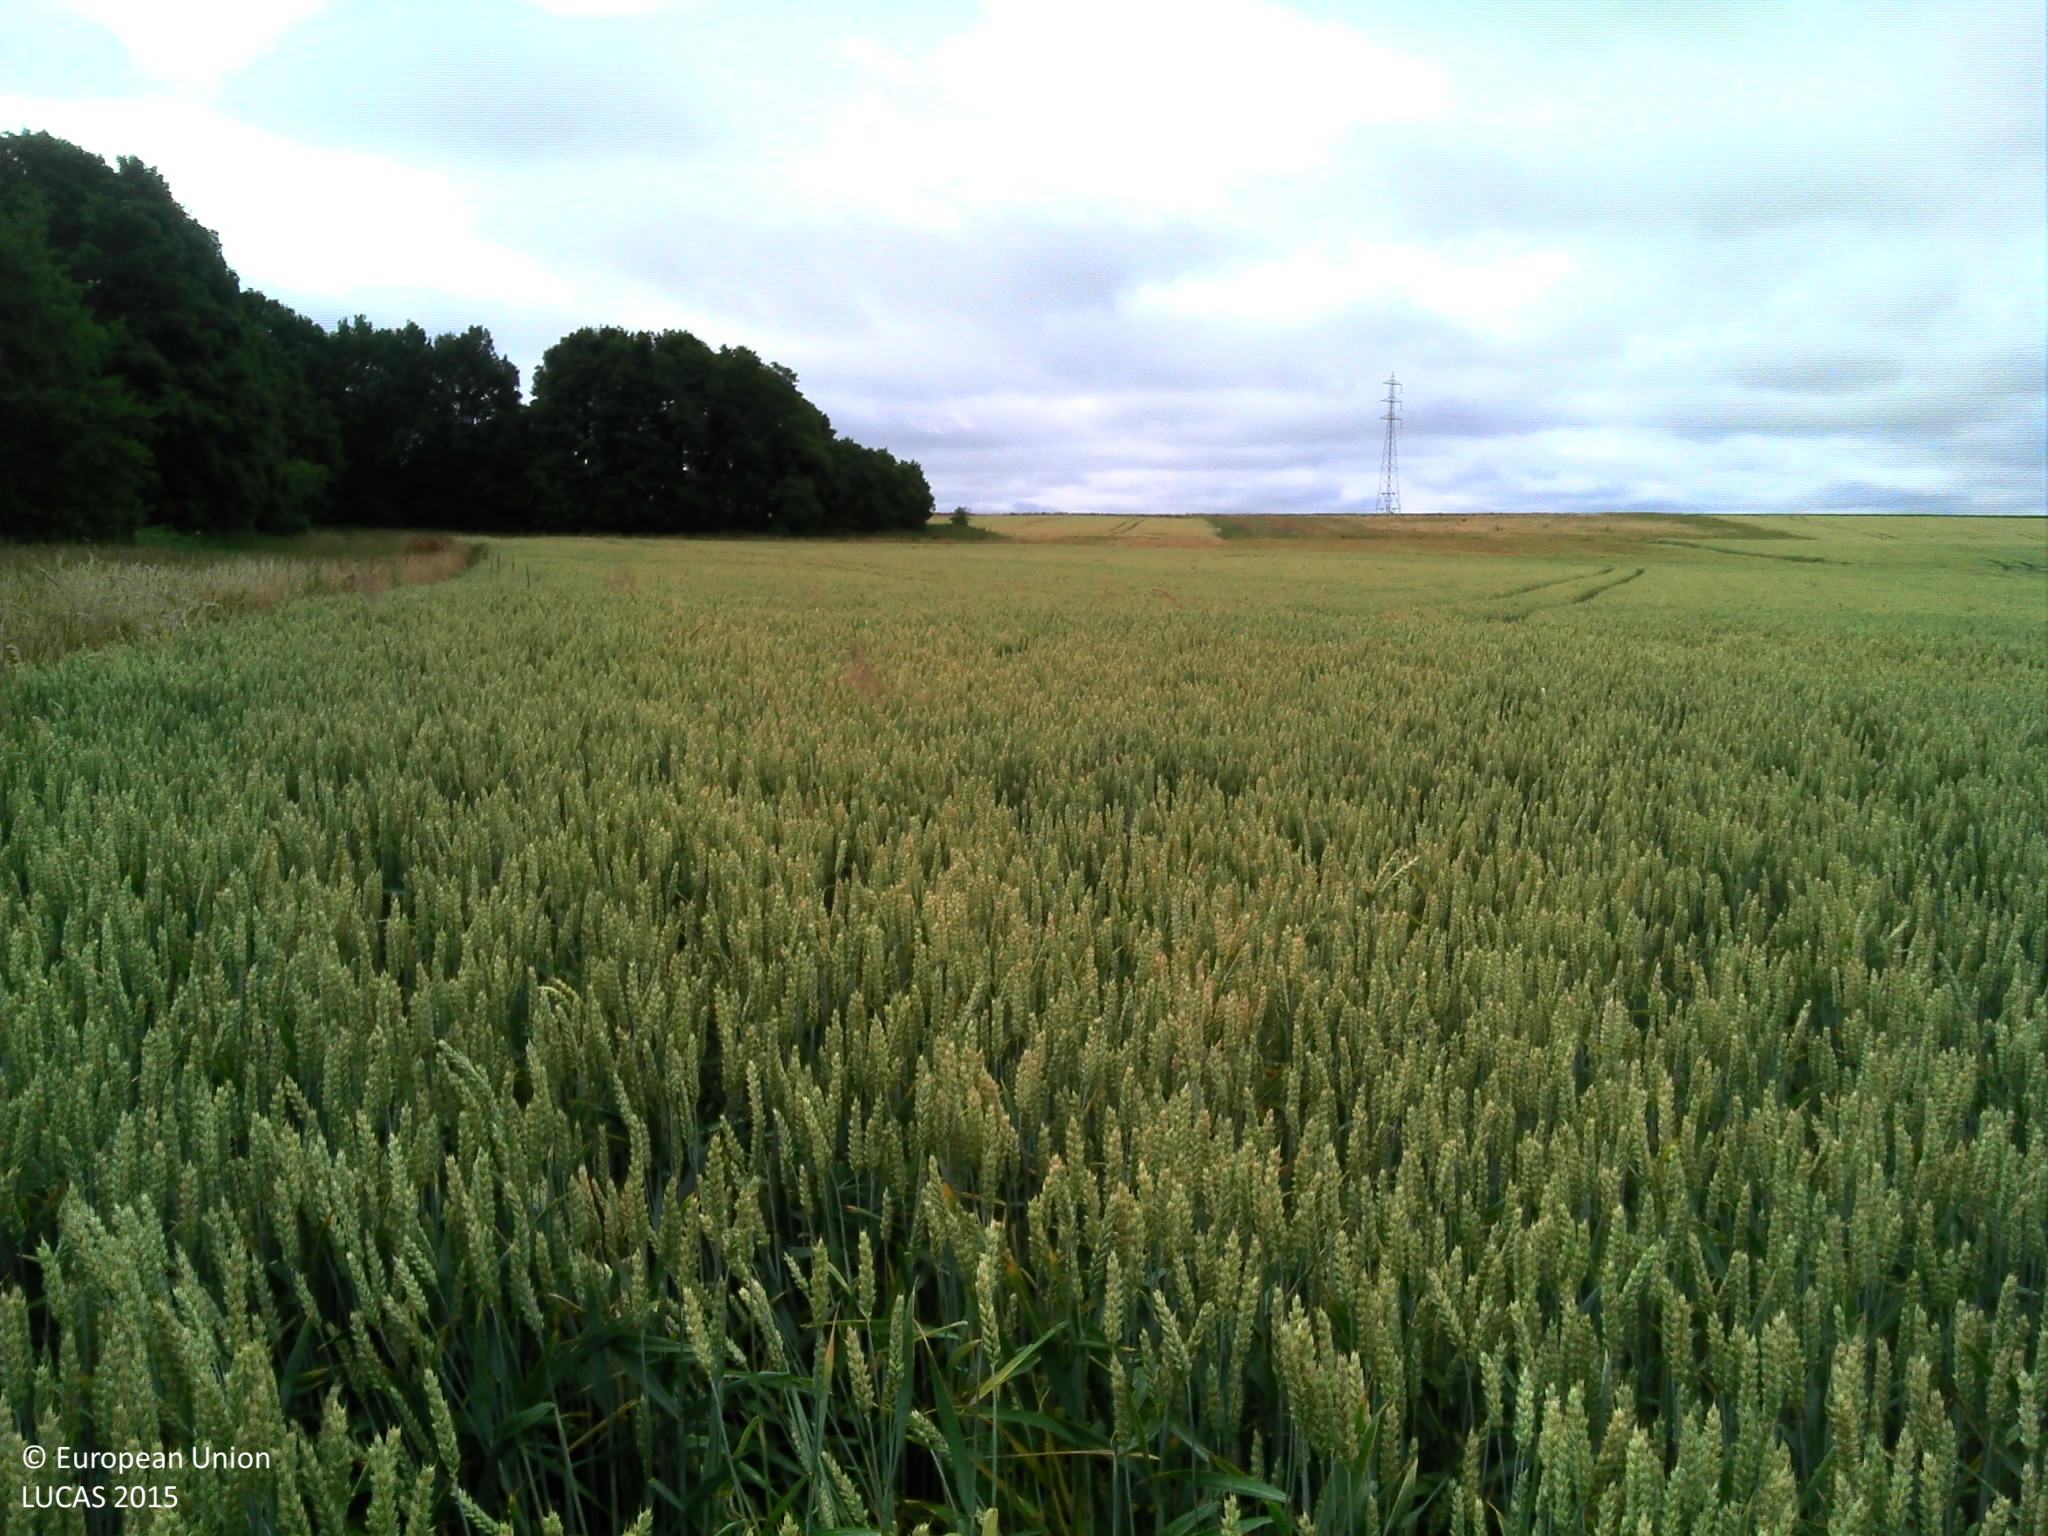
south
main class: Cropland
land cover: Common wheat
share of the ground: > 75 %
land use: Agriculture (excluding fallow land and kitchen gardens)
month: July
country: BE
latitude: 50.2146
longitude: 4.5166
